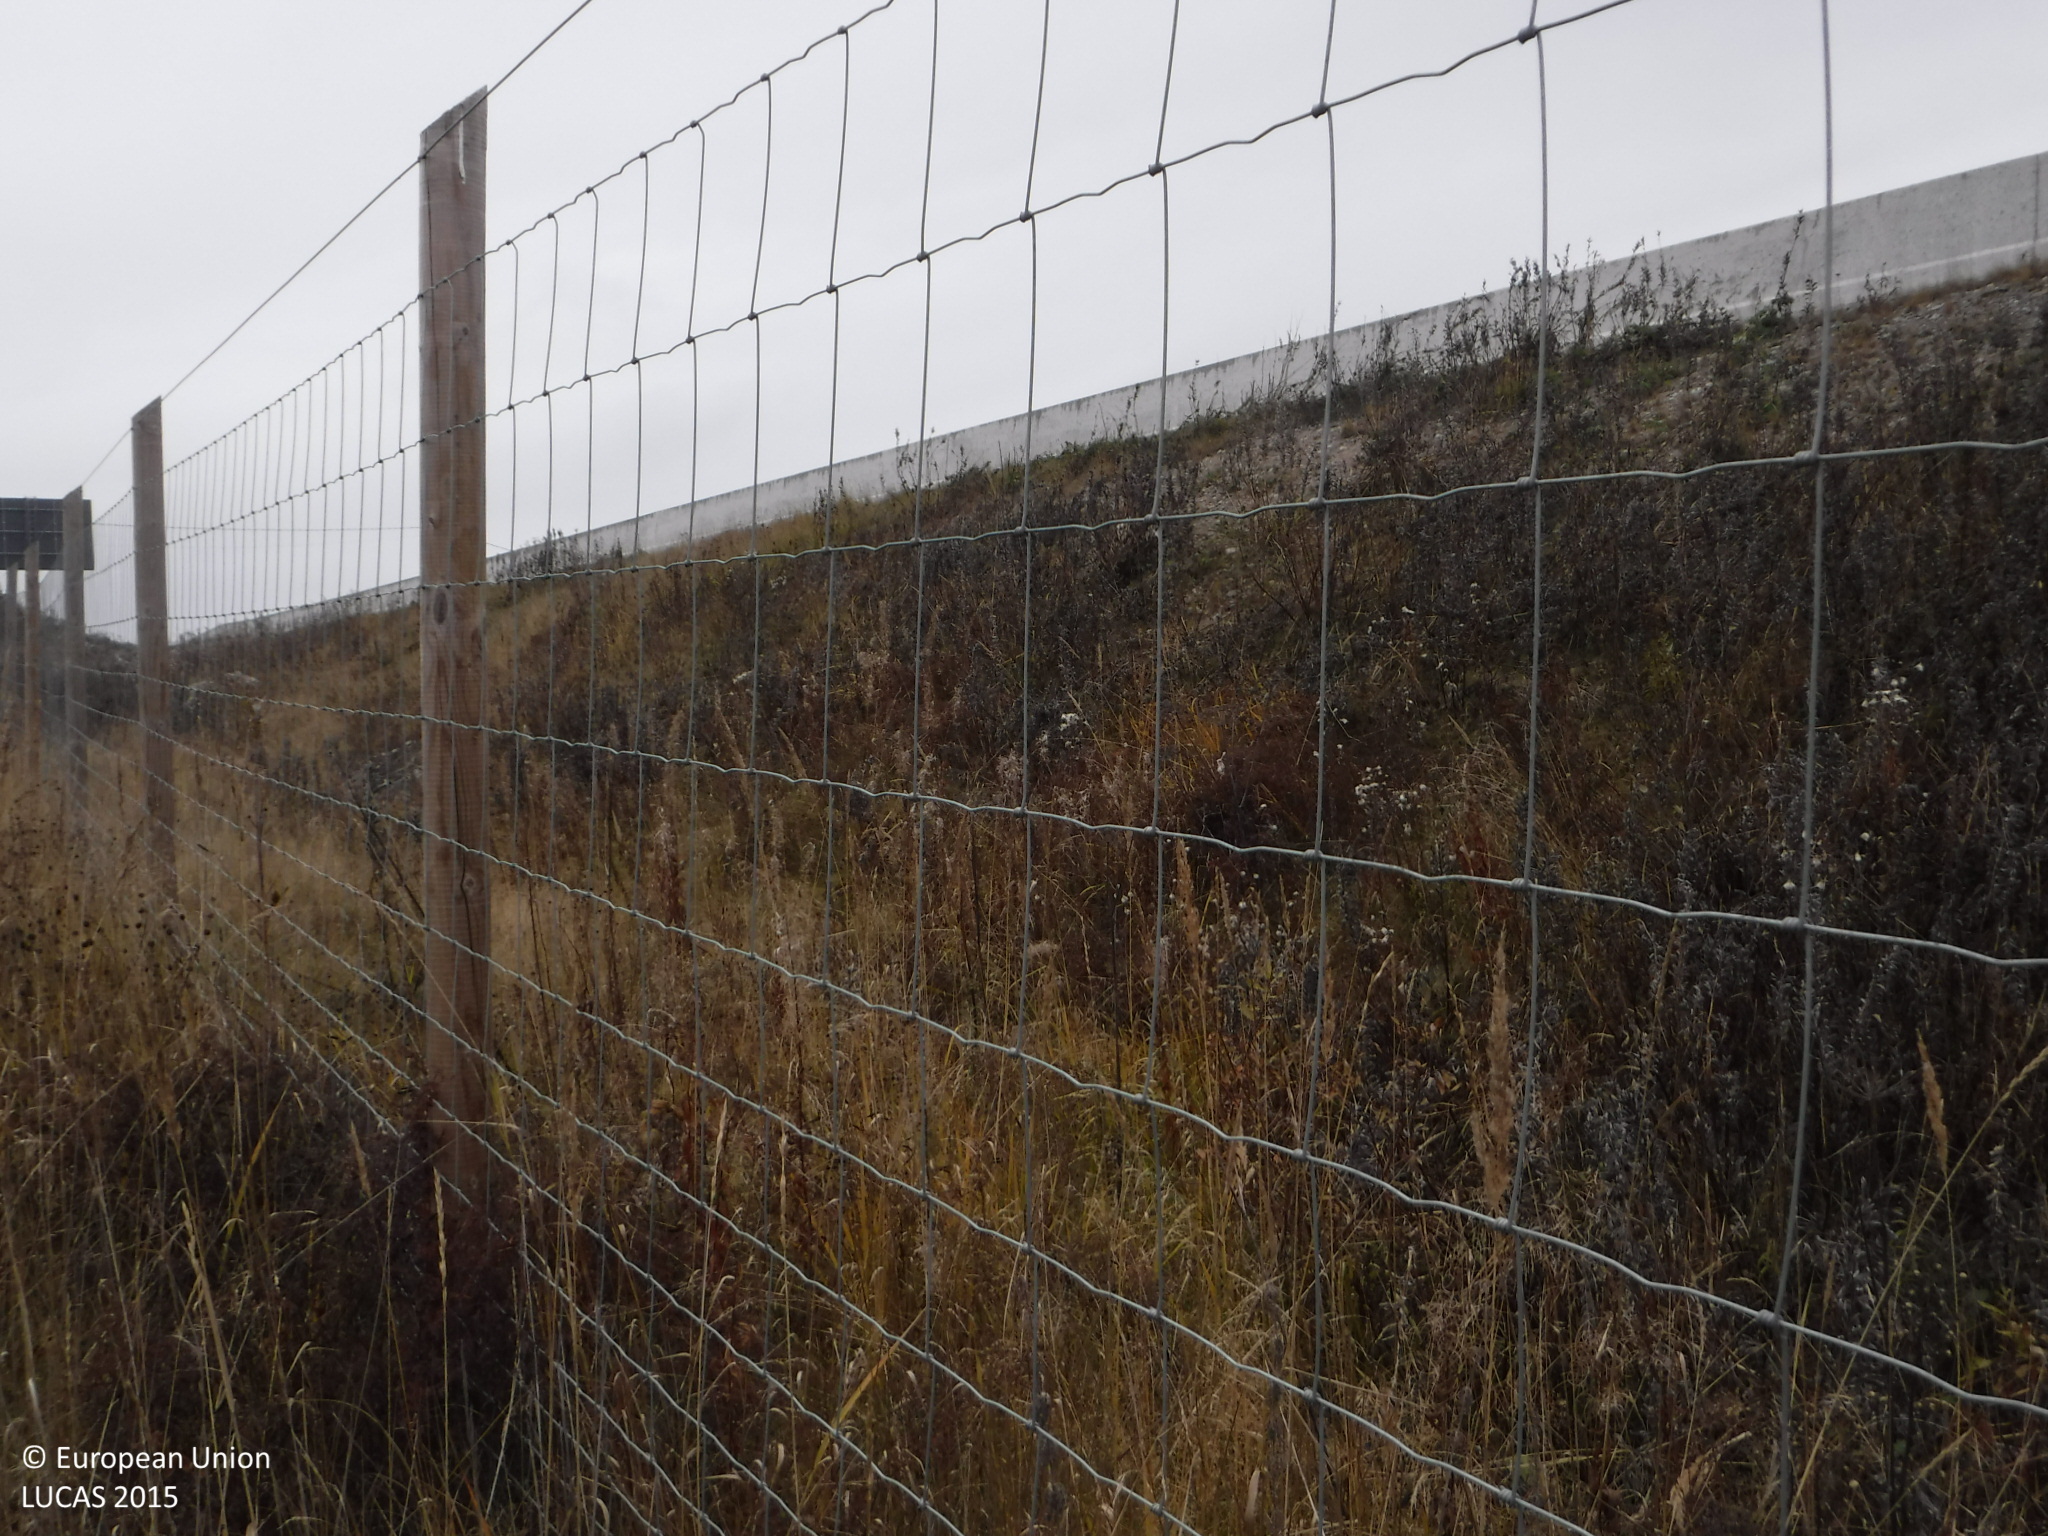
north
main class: Grassland
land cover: Spontaneously vegetated surfaces
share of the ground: > 75 %
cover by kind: herbaceous plants 100 %
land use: Road transport
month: October
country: FI
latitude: 62.0766
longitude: 26.0362
